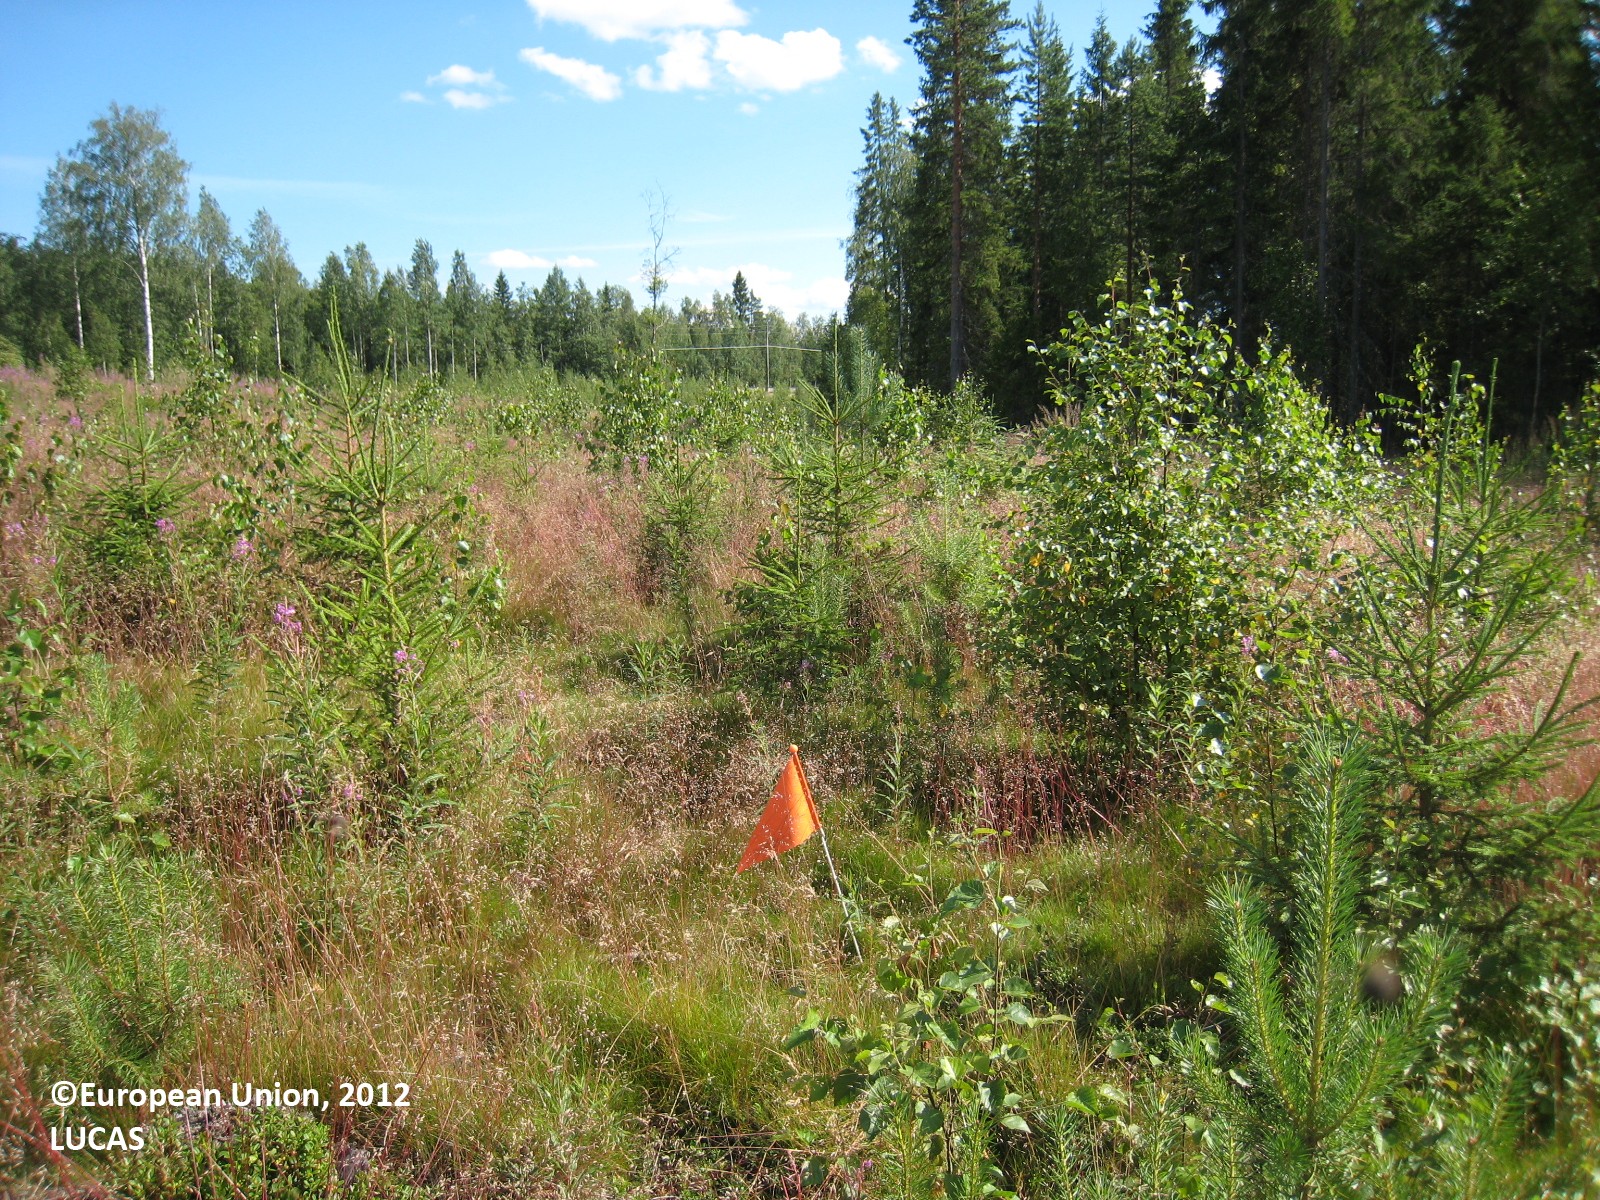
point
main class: Woodland
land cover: Other mixed woodland
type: boreal forest
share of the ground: 25 - 50 %
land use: Forestry
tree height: < 5 m
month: July
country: FI
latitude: 62.6937
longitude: 27.2947
